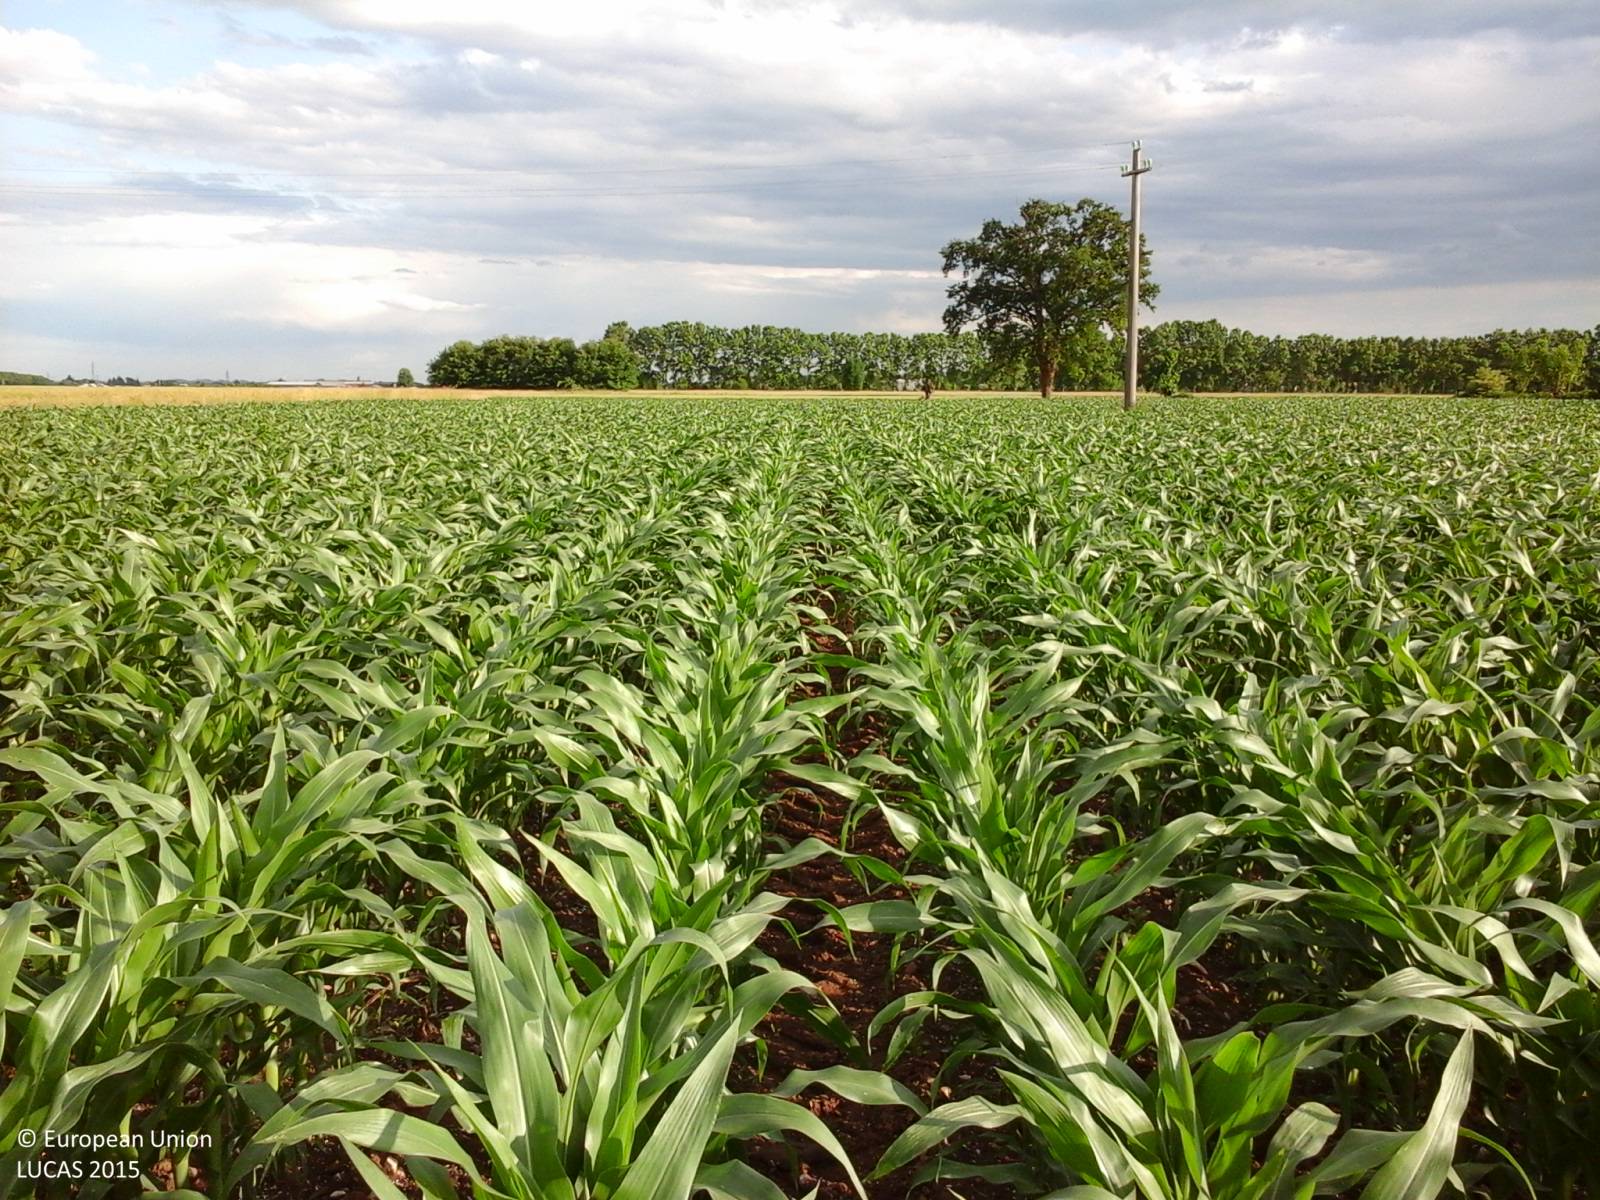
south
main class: Cropland
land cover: Maize
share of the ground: > 75 %
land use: Agriculture (excluding fallow land and kitchen gardens)
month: May
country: IT
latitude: 46.1390
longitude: 13.2716
